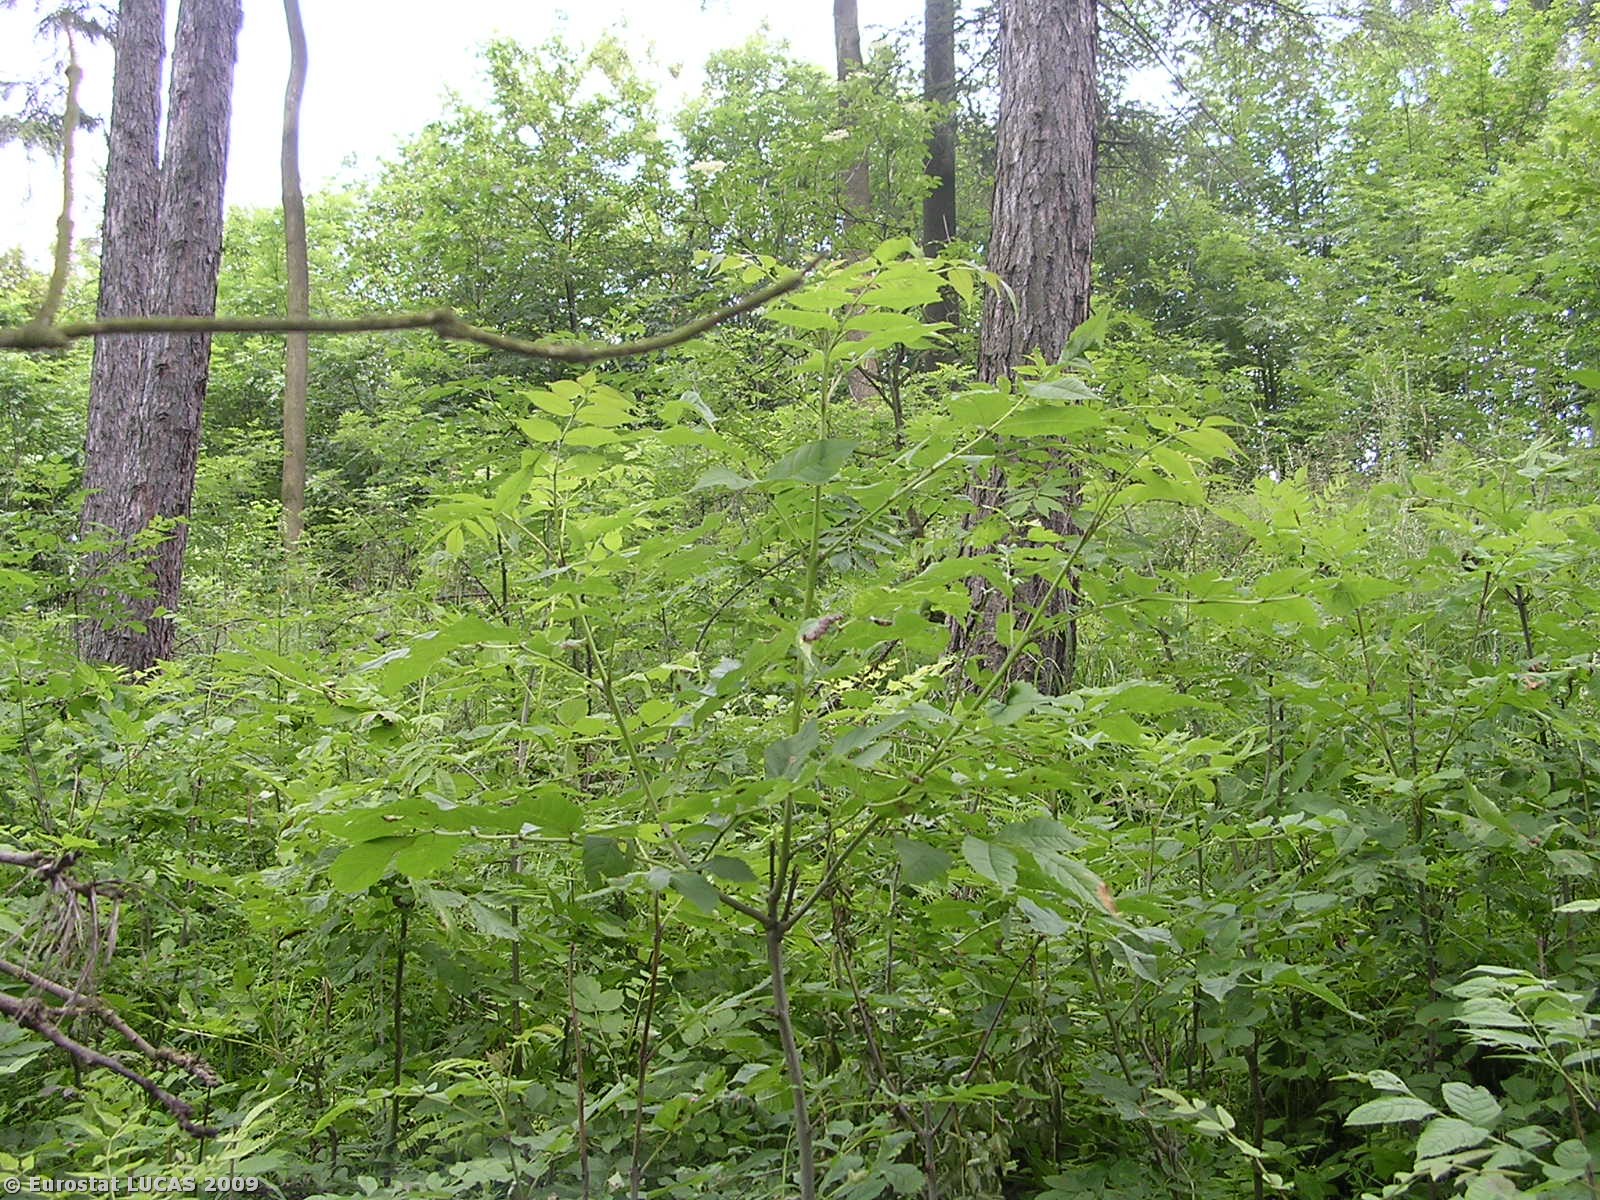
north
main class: Woodland
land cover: Mixed woodland
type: hemiboreal forest and nemoral coniferous forest and mixed broadleaved-coniferous forest
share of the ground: > 75 %
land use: Forestry
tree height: > 5 m
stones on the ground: < 10 %
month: June
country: CZ
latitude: 50.6291
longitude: 14.2000
